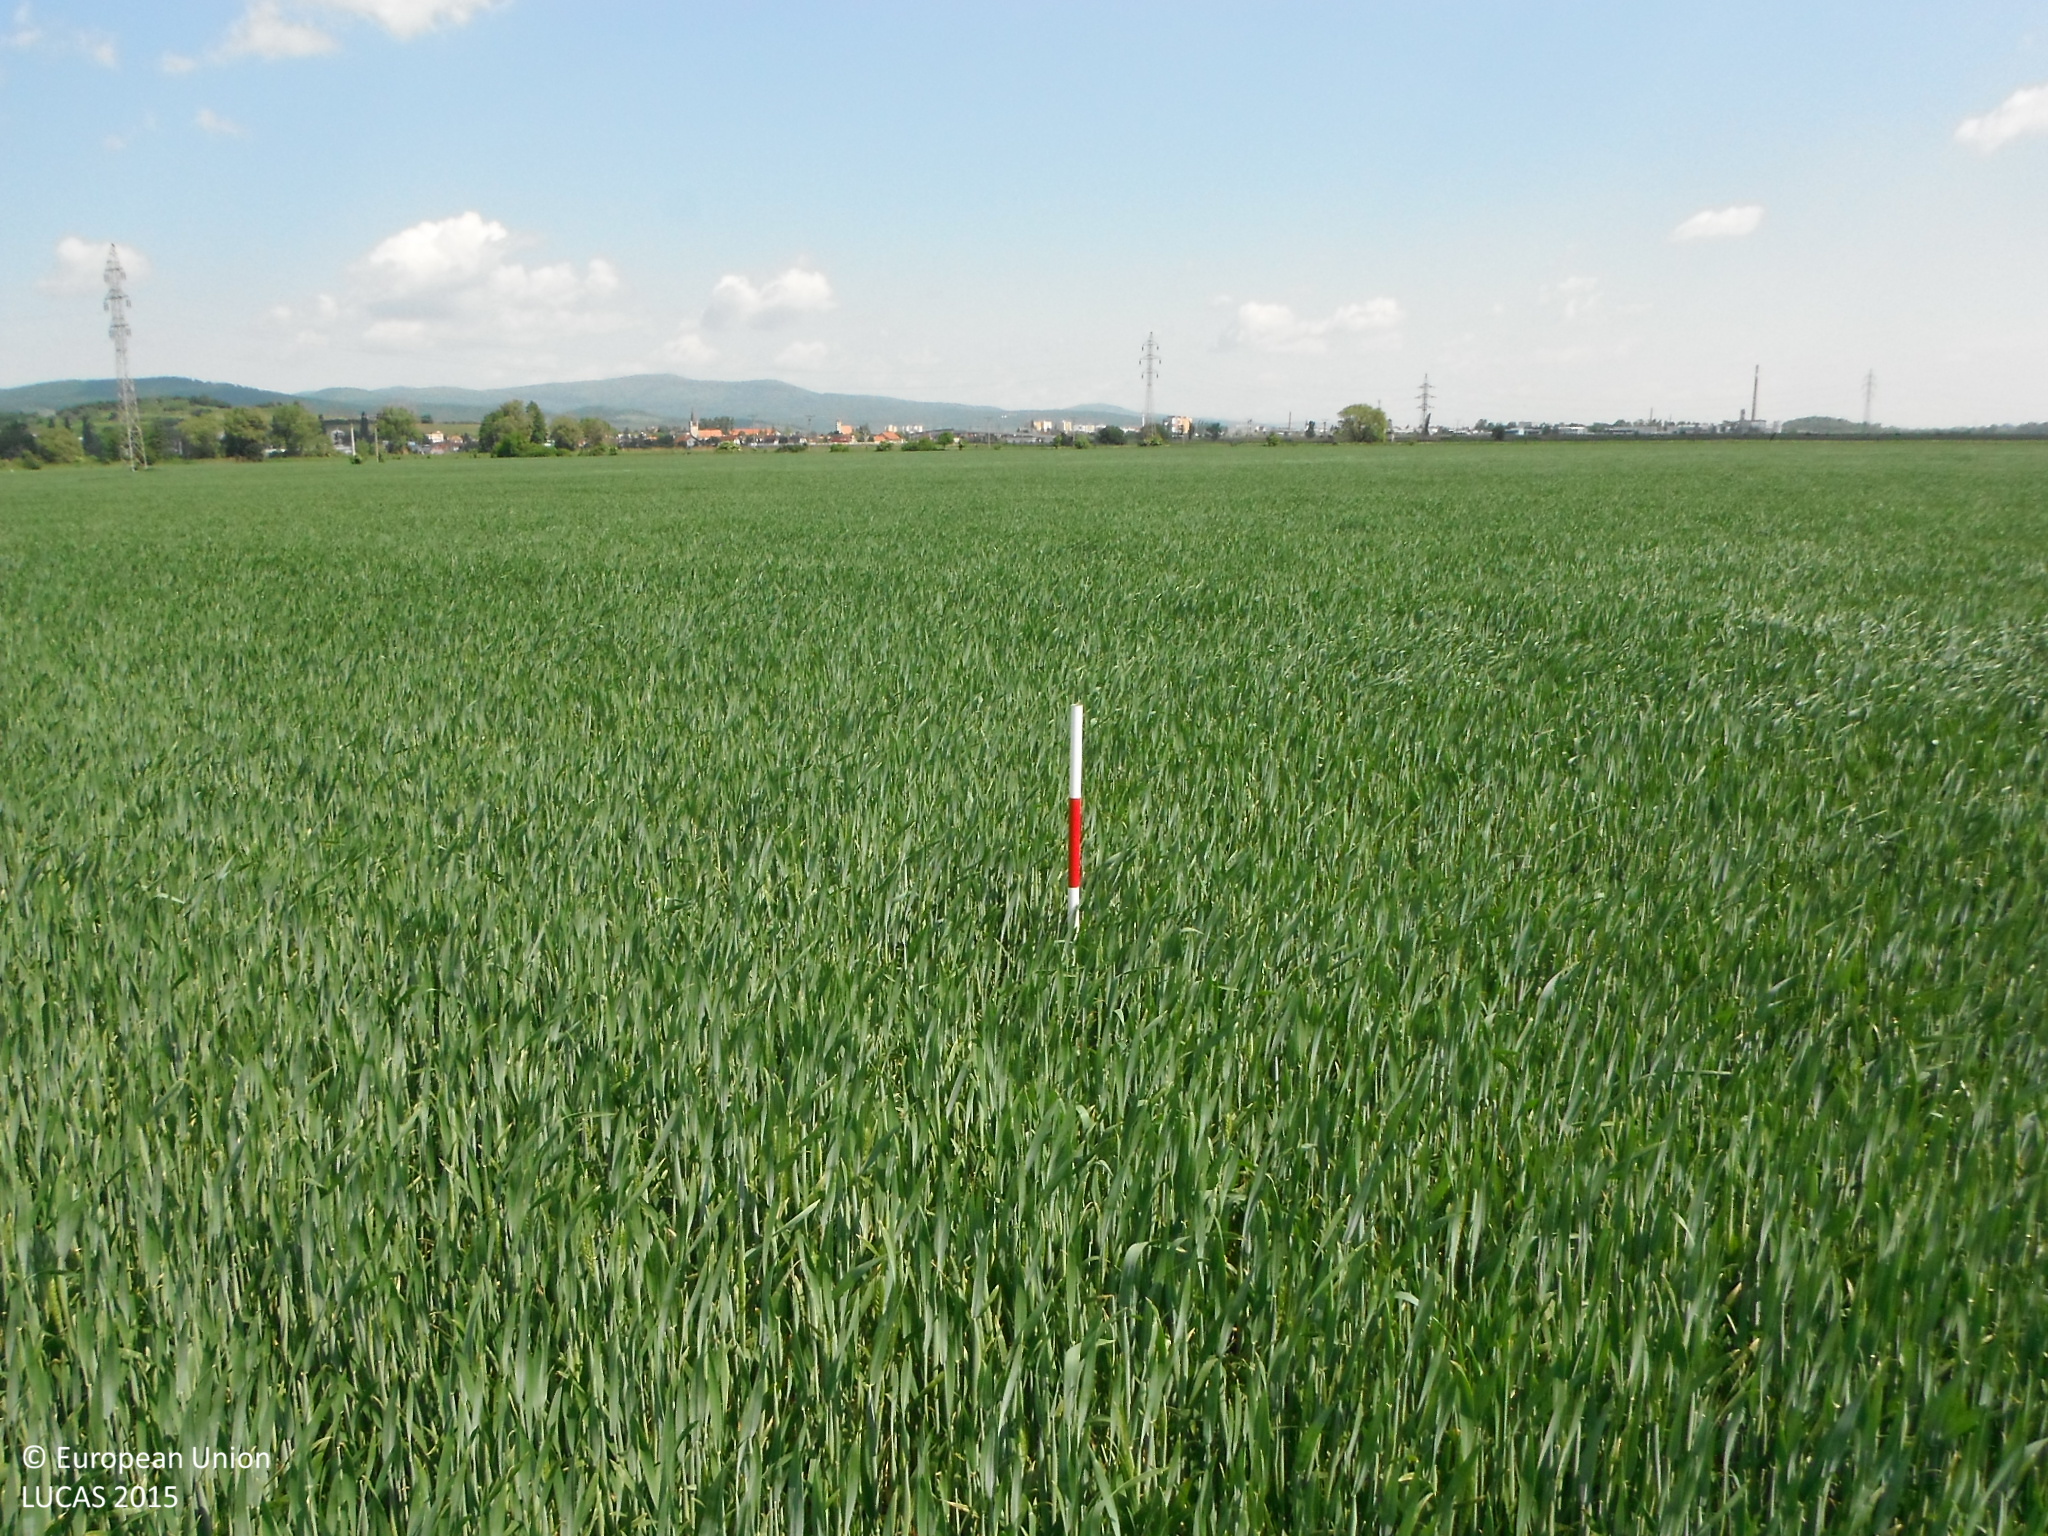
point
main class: Cropland
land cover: Common wheat
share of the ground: > 75 %
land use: Agriculture (excluding fallow land and kitchen gardens)
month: May
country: SK
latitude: 48.2562
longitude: 17.2418
